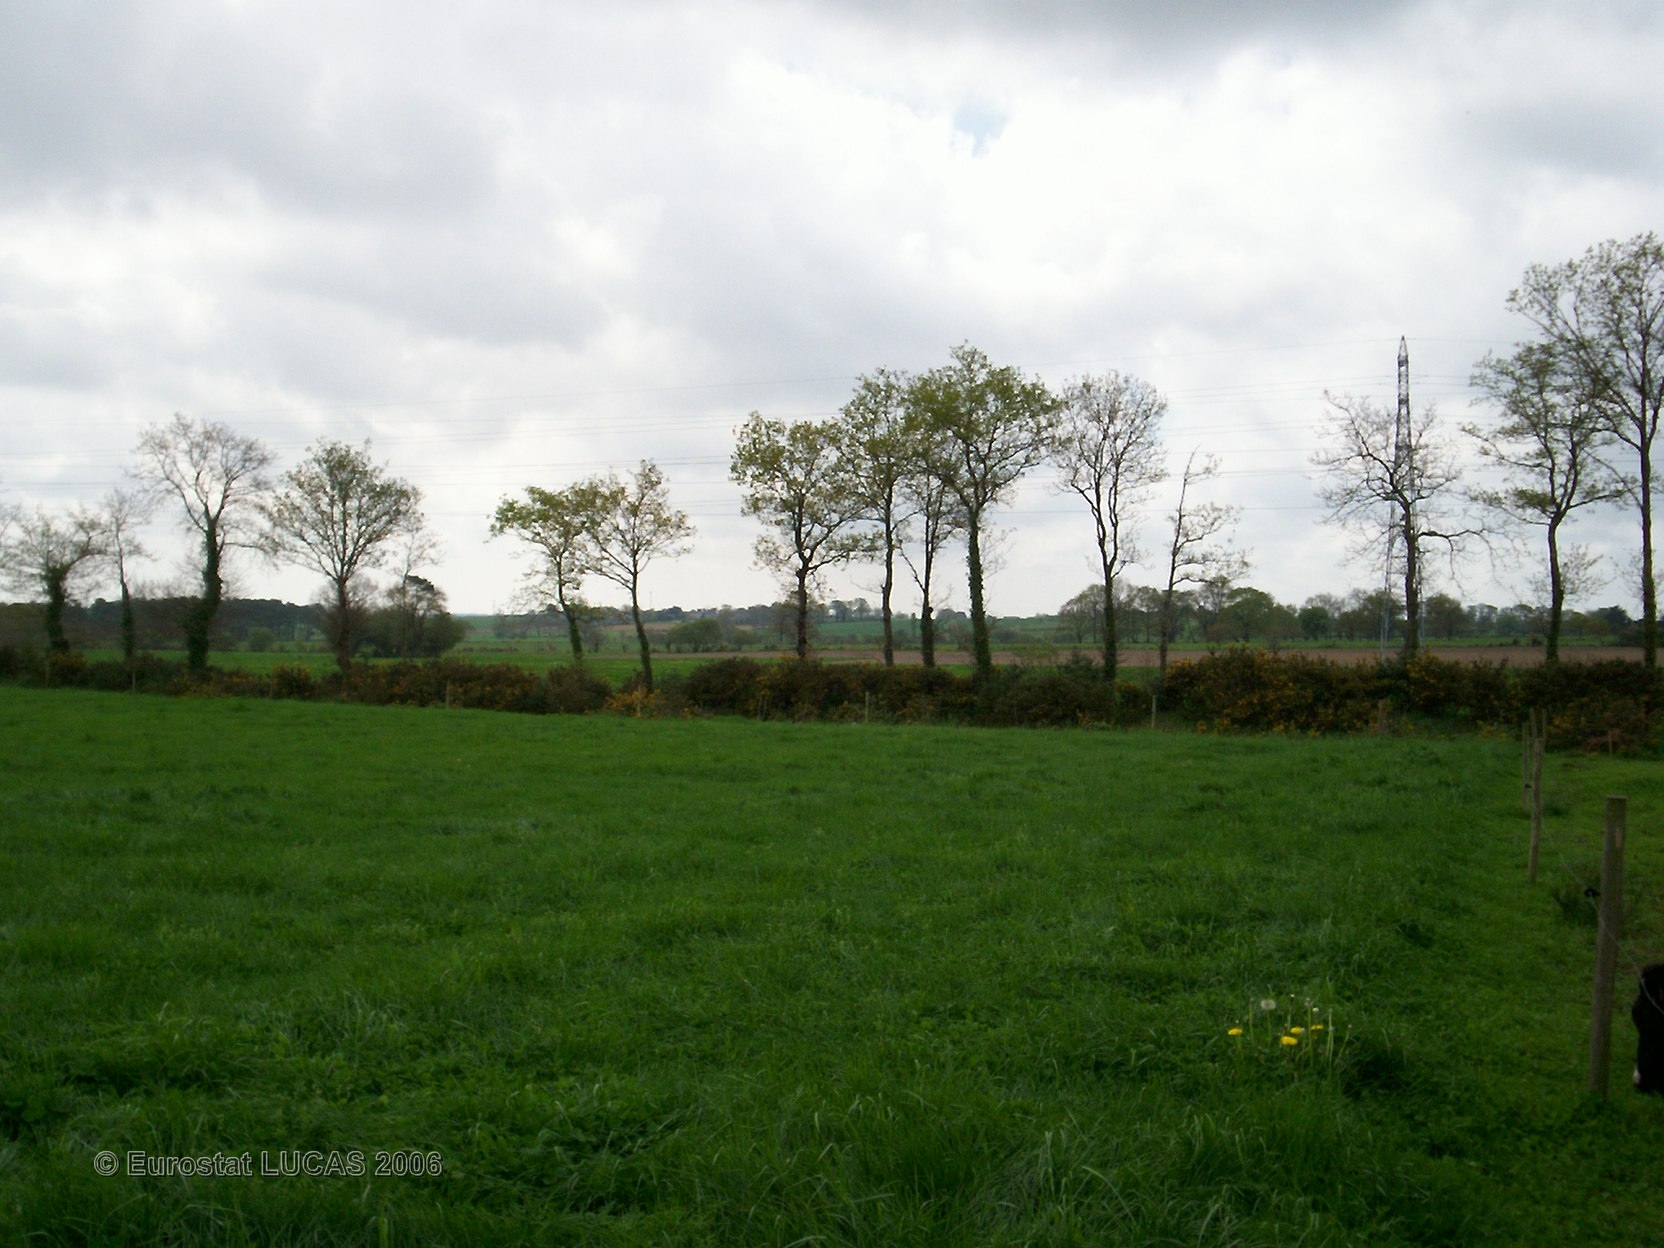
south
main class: Grassland
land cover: Grassland without tree/shrub cover
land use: Agriculture (excluding fallow land and kitchen gardens)
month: May
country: FR
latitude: 47.6531
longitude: -2.6687
